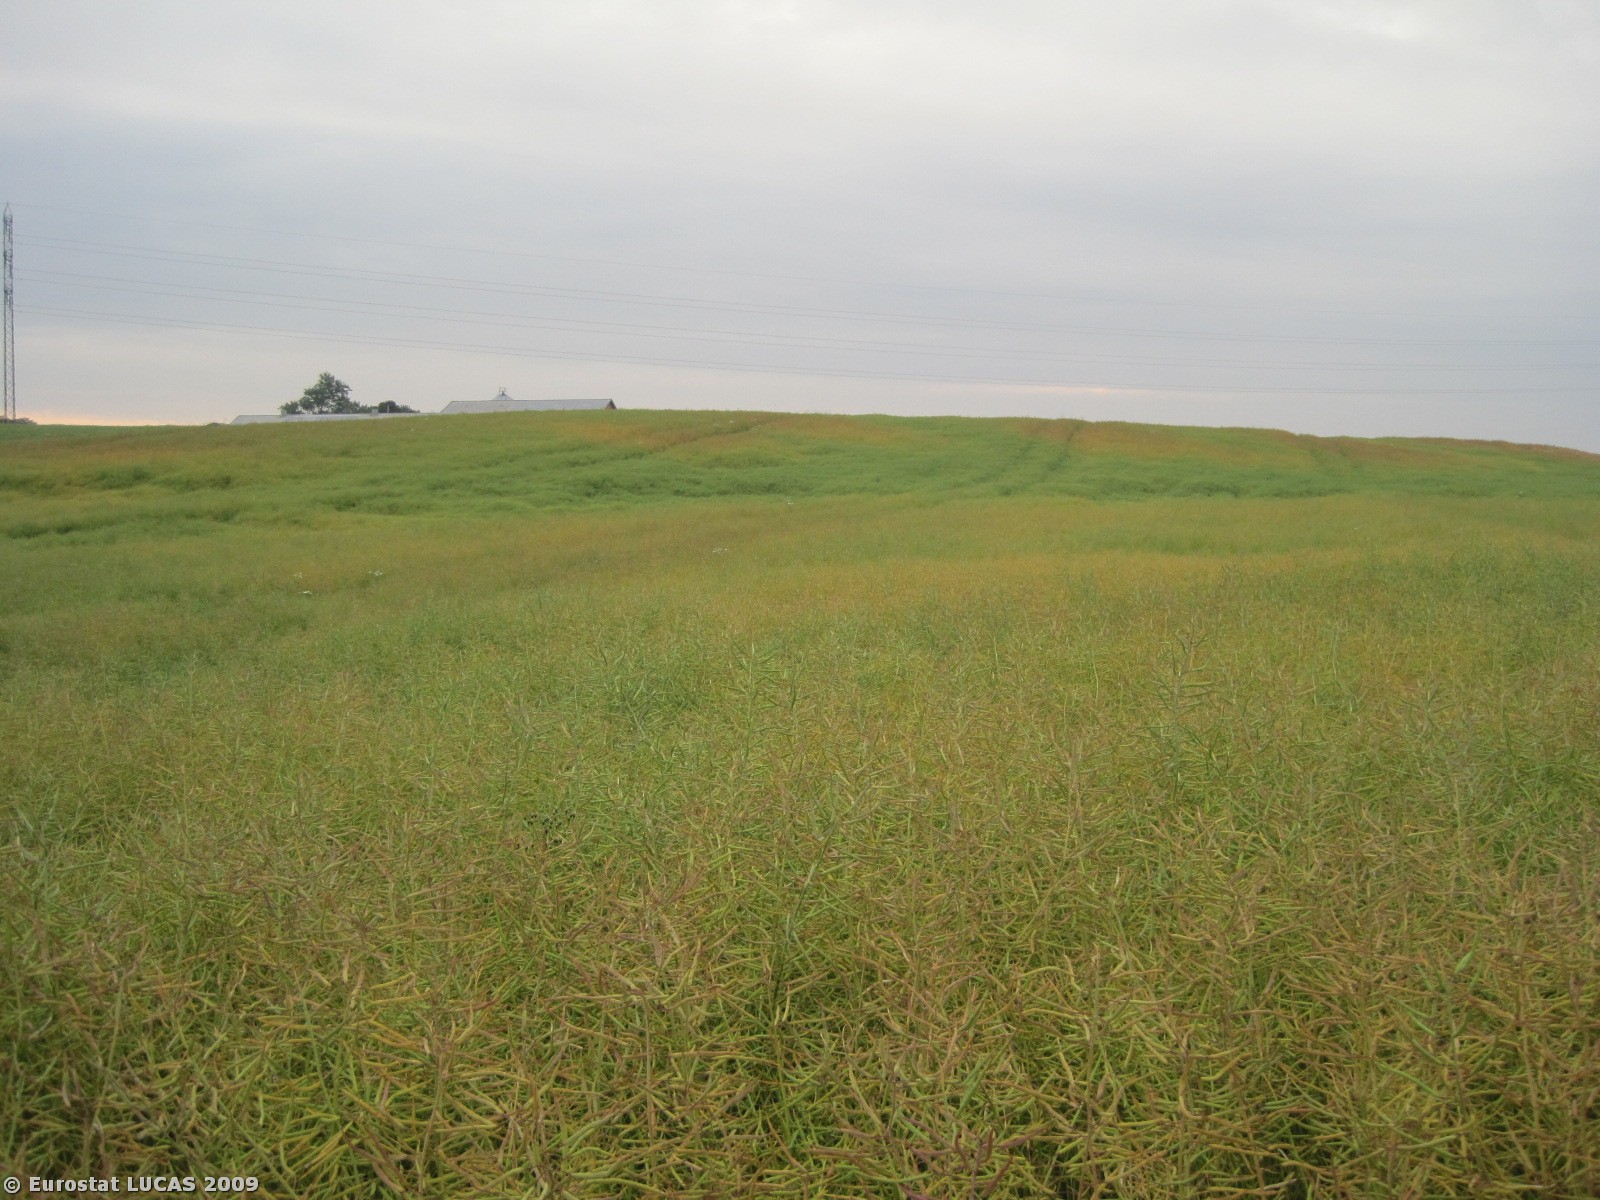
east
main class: Cropland
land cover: Rape and turnip rape
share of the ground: > 75 %
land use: Agriculture (excluding fallow land and kitchen gardens)
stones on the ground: 25 - 50 %
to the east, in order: Rape and turnip rape; Electric lines; Rape and turnip rape; Grass margins; Tracks; Grassland without tree/shrub cover; Artificial constructions in urban areas; Grassland without tree/shrub cover; Barley
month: June
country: DK
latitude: 56.5029
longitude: 8.5234
